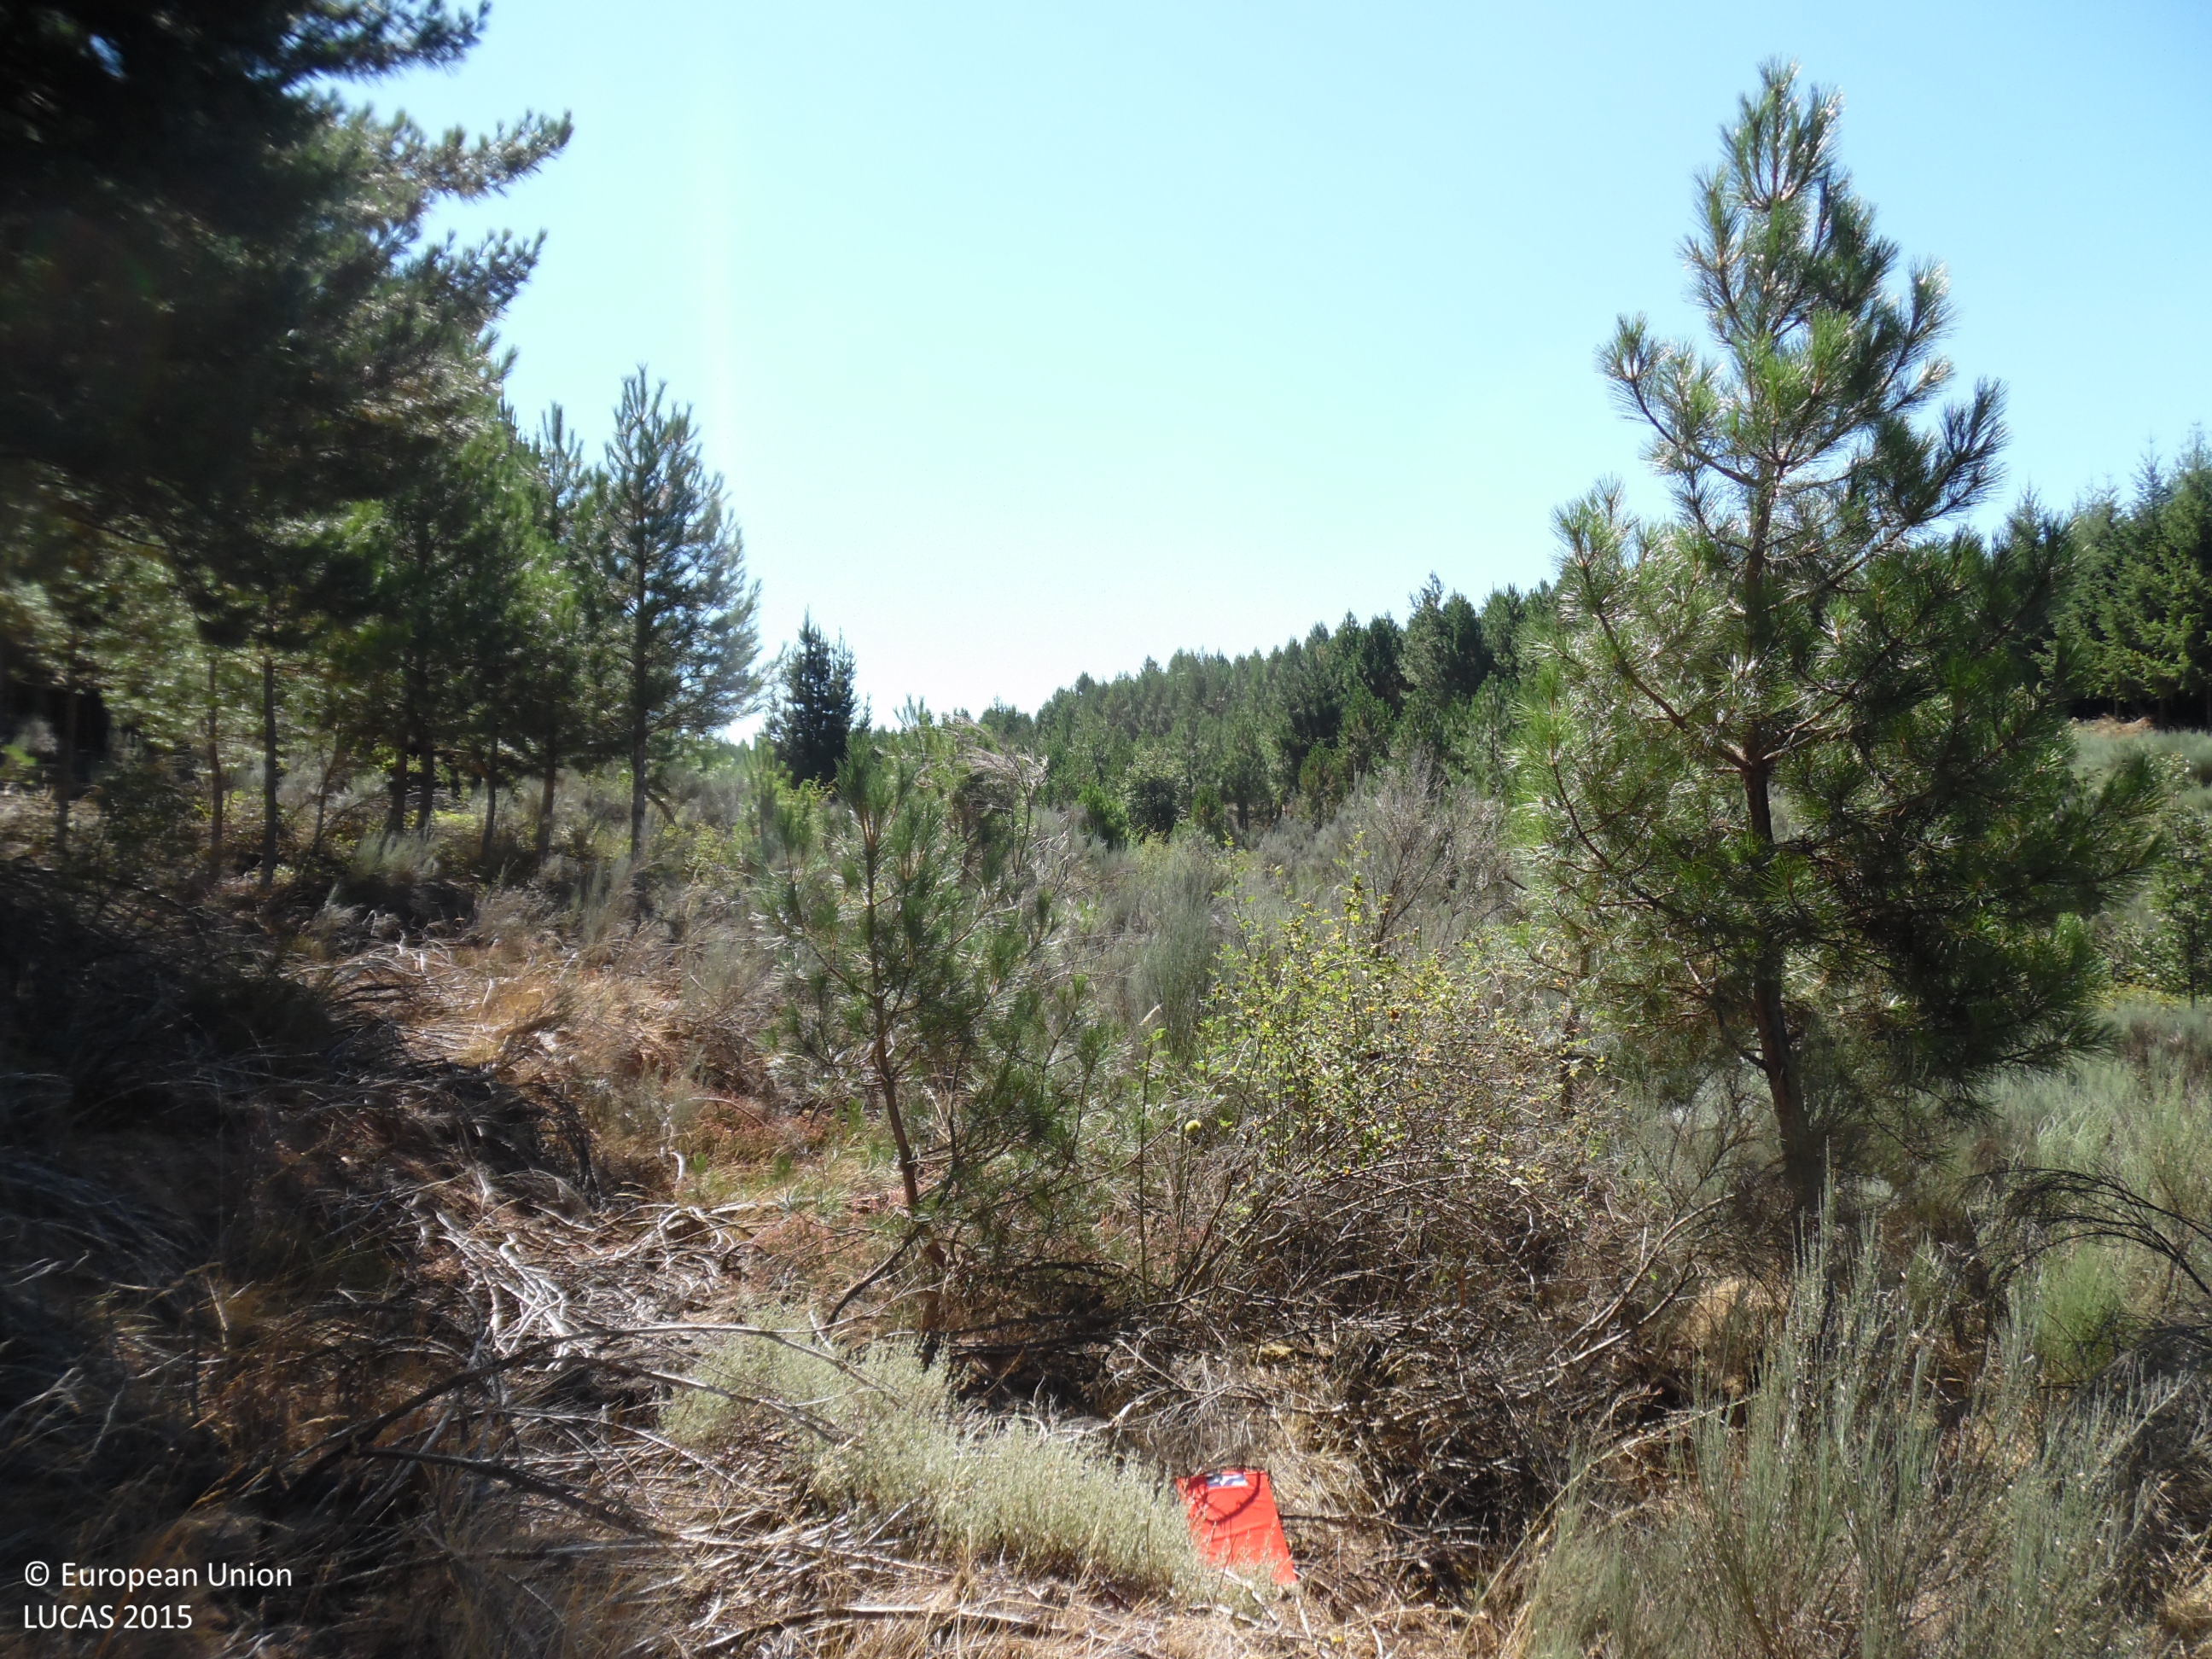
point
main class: Shrubland
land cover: Shrubland with sparse tree cover
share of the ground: > 75 %
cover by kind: shrubs 95 %, coniferous forest trees 5 %
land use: Abandoned areas
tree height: < 5 m
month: August
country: ES
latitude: 42.6802
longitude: -6.4337
